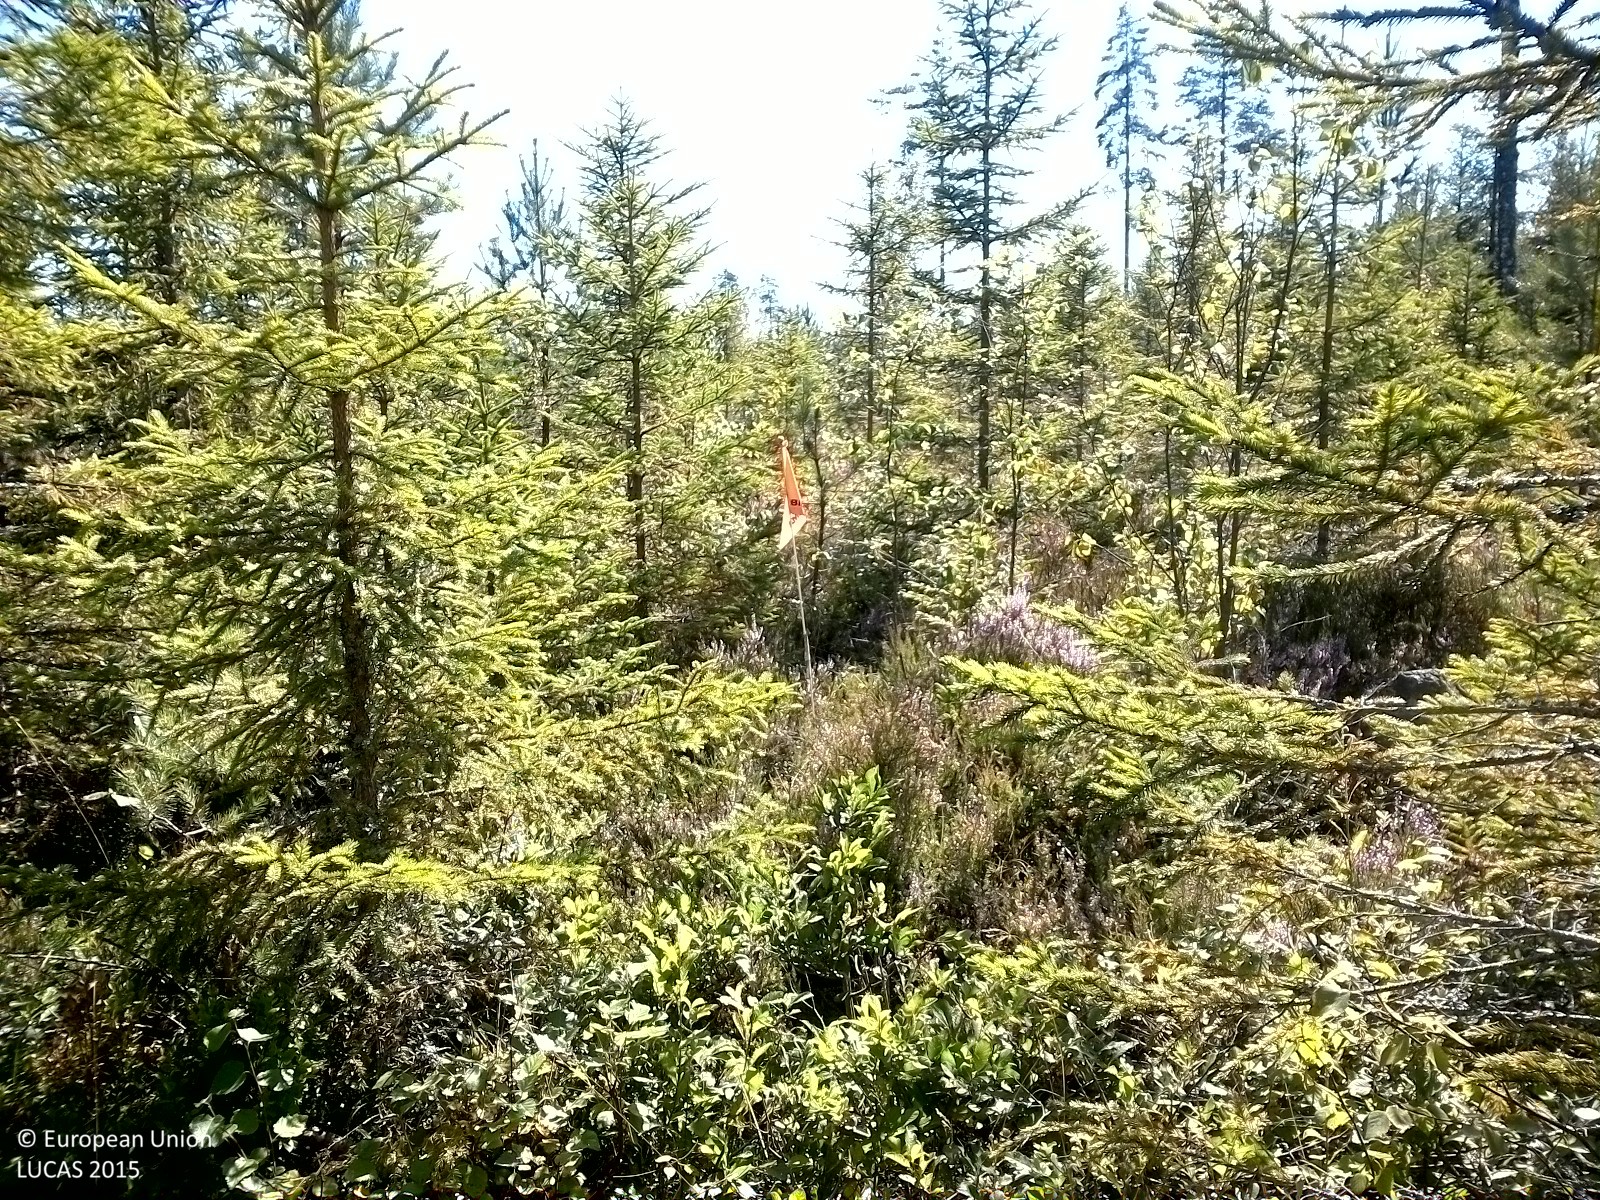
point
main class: Woodland
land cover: Other coniferous woodland
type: boreal forest
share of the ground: 50 - 75 %
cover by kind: coniferous forest trees 60 %, shrubs 25 %, broadleaved forest trees 5 %, herbaceous plants 5 %, lichens and mosses 5 %
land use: Forestry
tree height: < 5 m
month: August
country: SE
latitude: 59.4340
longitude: 14.7335
